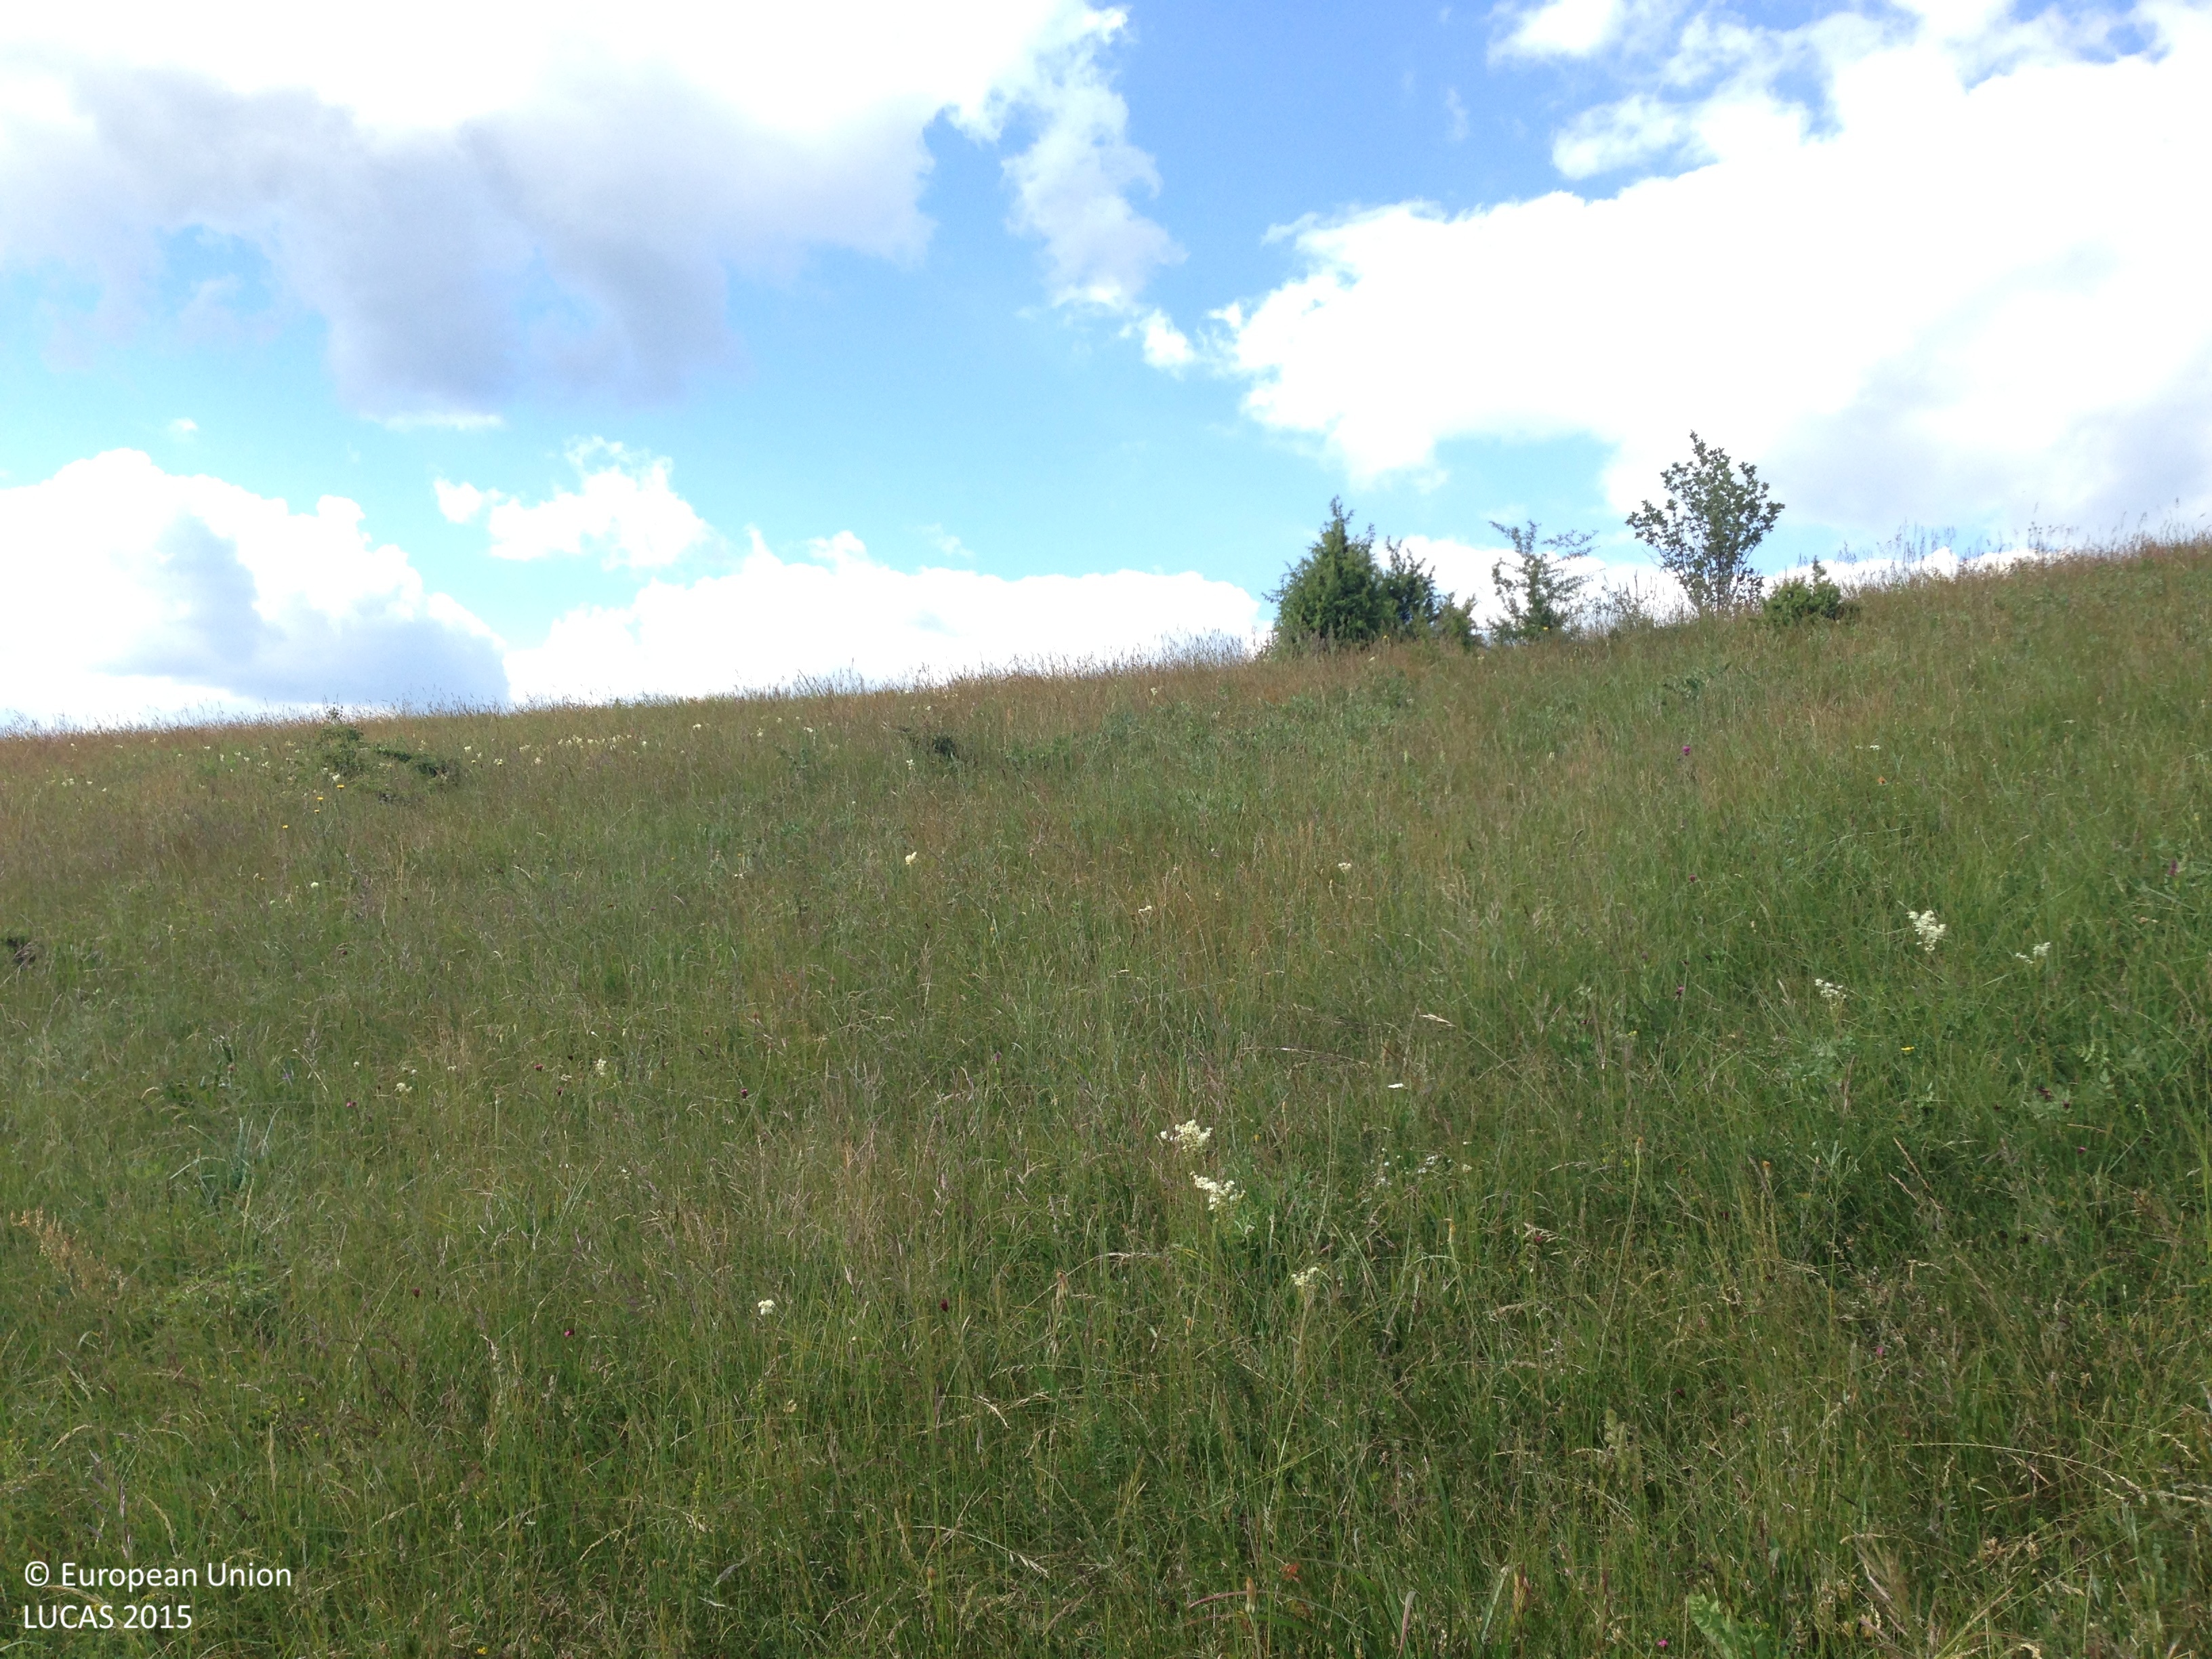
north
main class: Grassland
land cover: Grassland with sparse tree/shrub cover
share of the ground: > 75 %
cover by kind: herbaceous plants 85 %, broadleaved forest trees 5 %, shrubs 5 %, unconsolidated bare surface 5 %
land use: Agriculture (excluding fallow land and kitchen gardens)
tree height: < 5 m
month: June
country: HR
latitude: 44.7587
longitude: 15.6159
